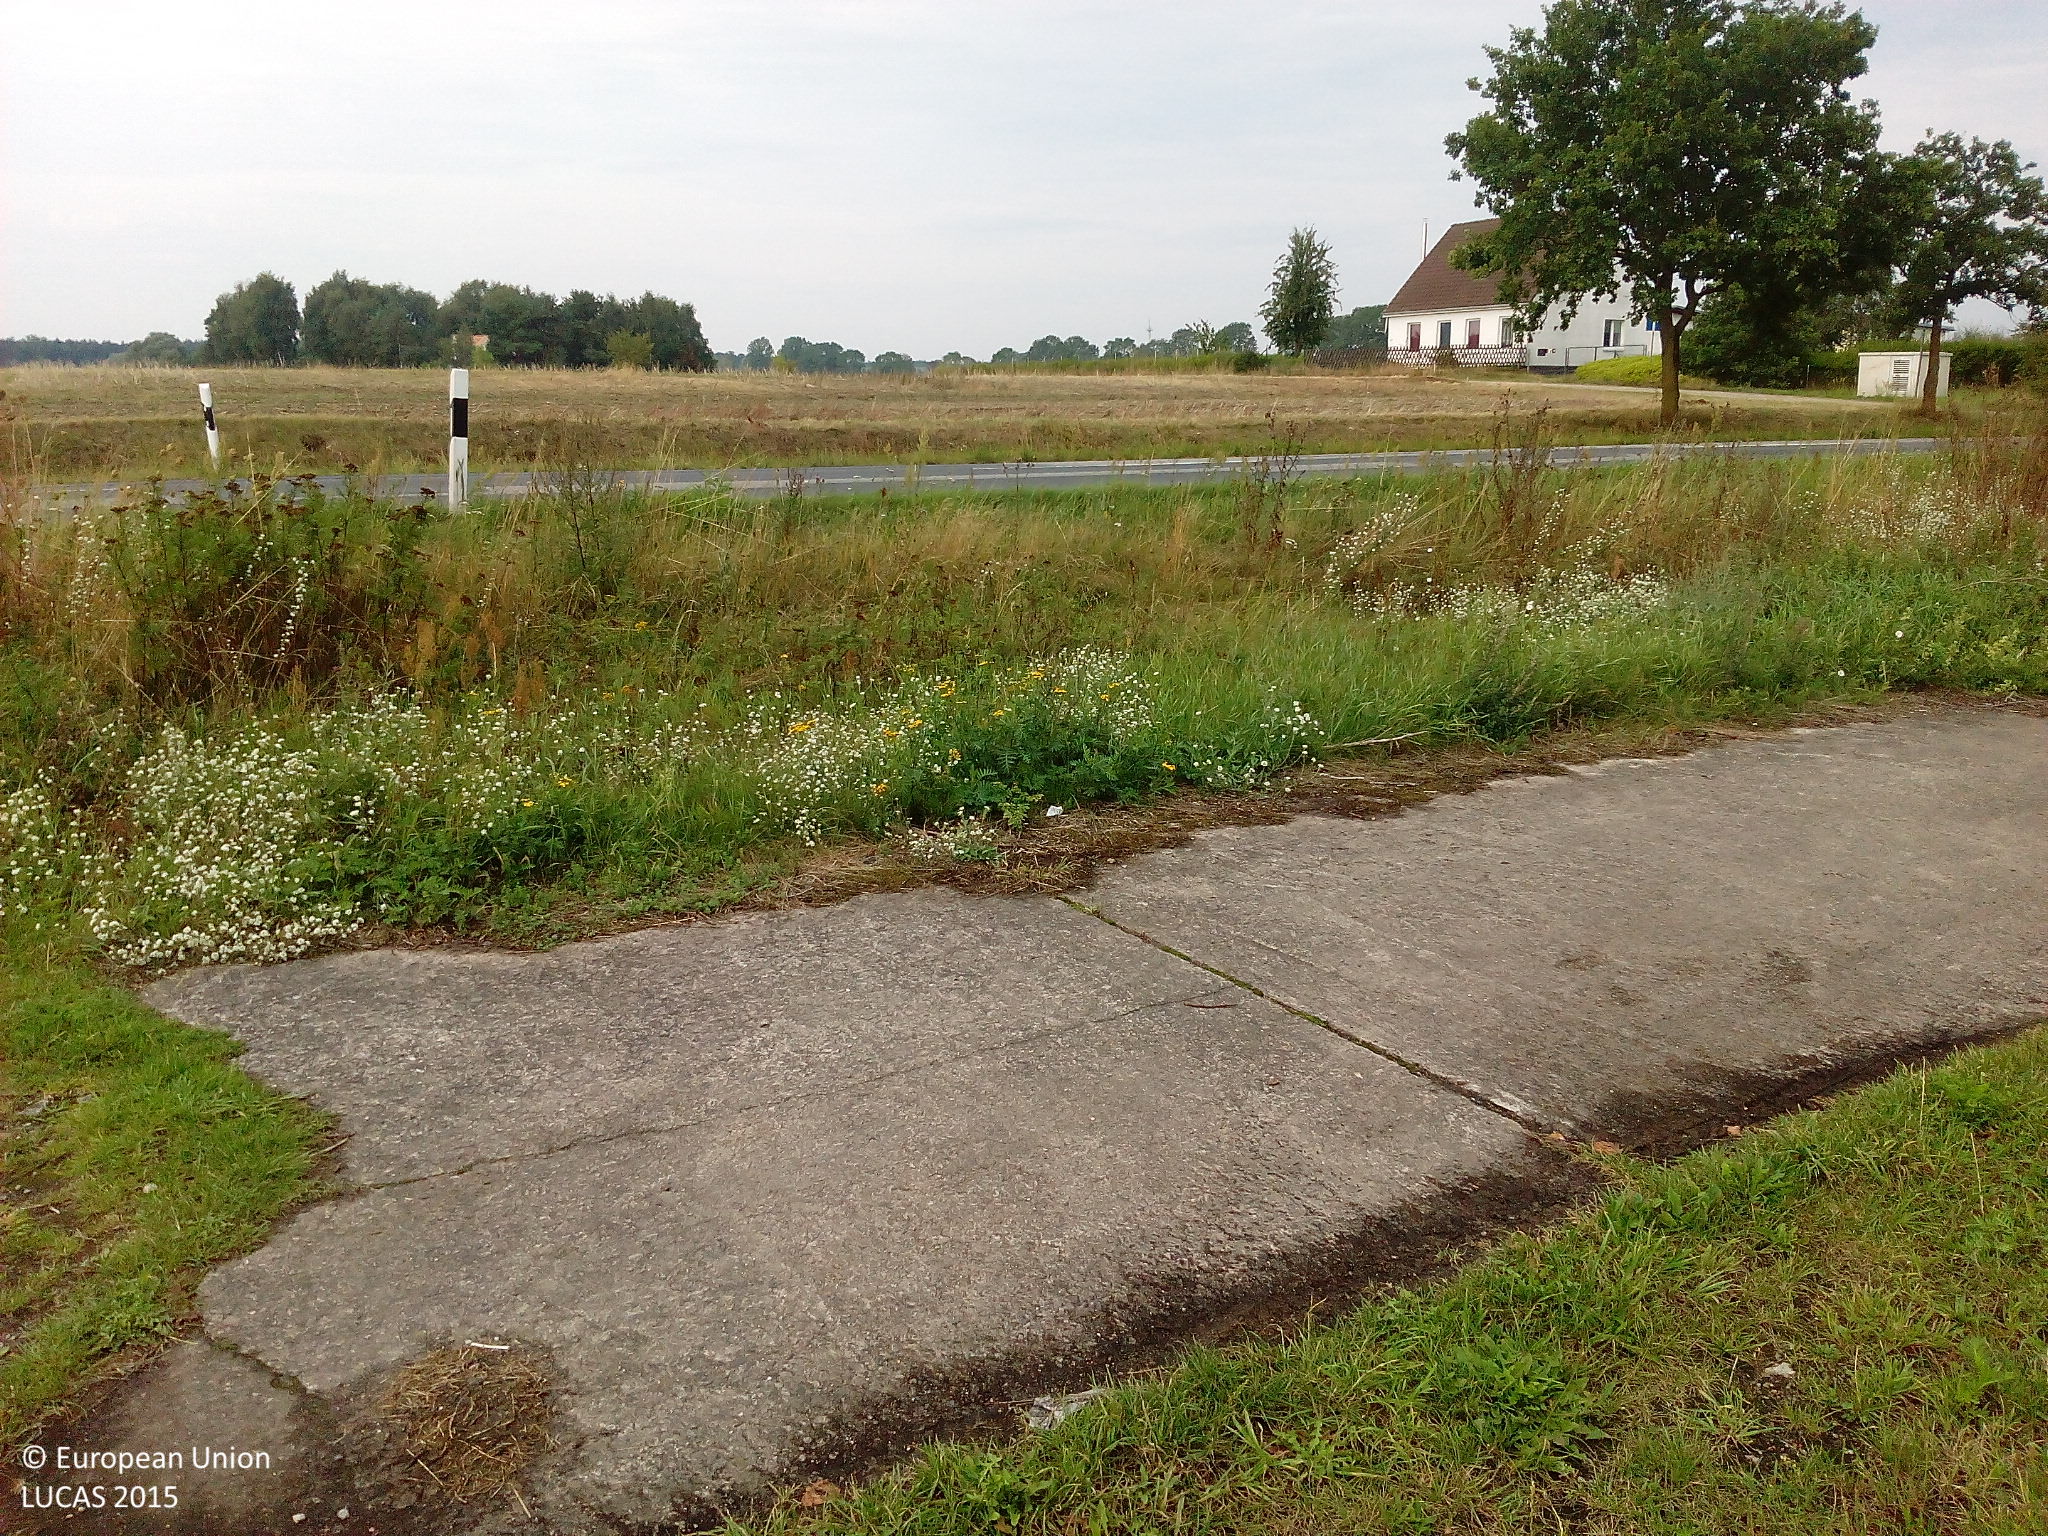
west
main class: Grassland
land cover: Spontaneously vegetated surfaces
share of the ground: > 75 %
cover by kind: herbaceous plants 100 %
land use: Semi-natural and natural areas not in use
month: August
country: DE
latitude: 54.0911
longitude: 12.7052
